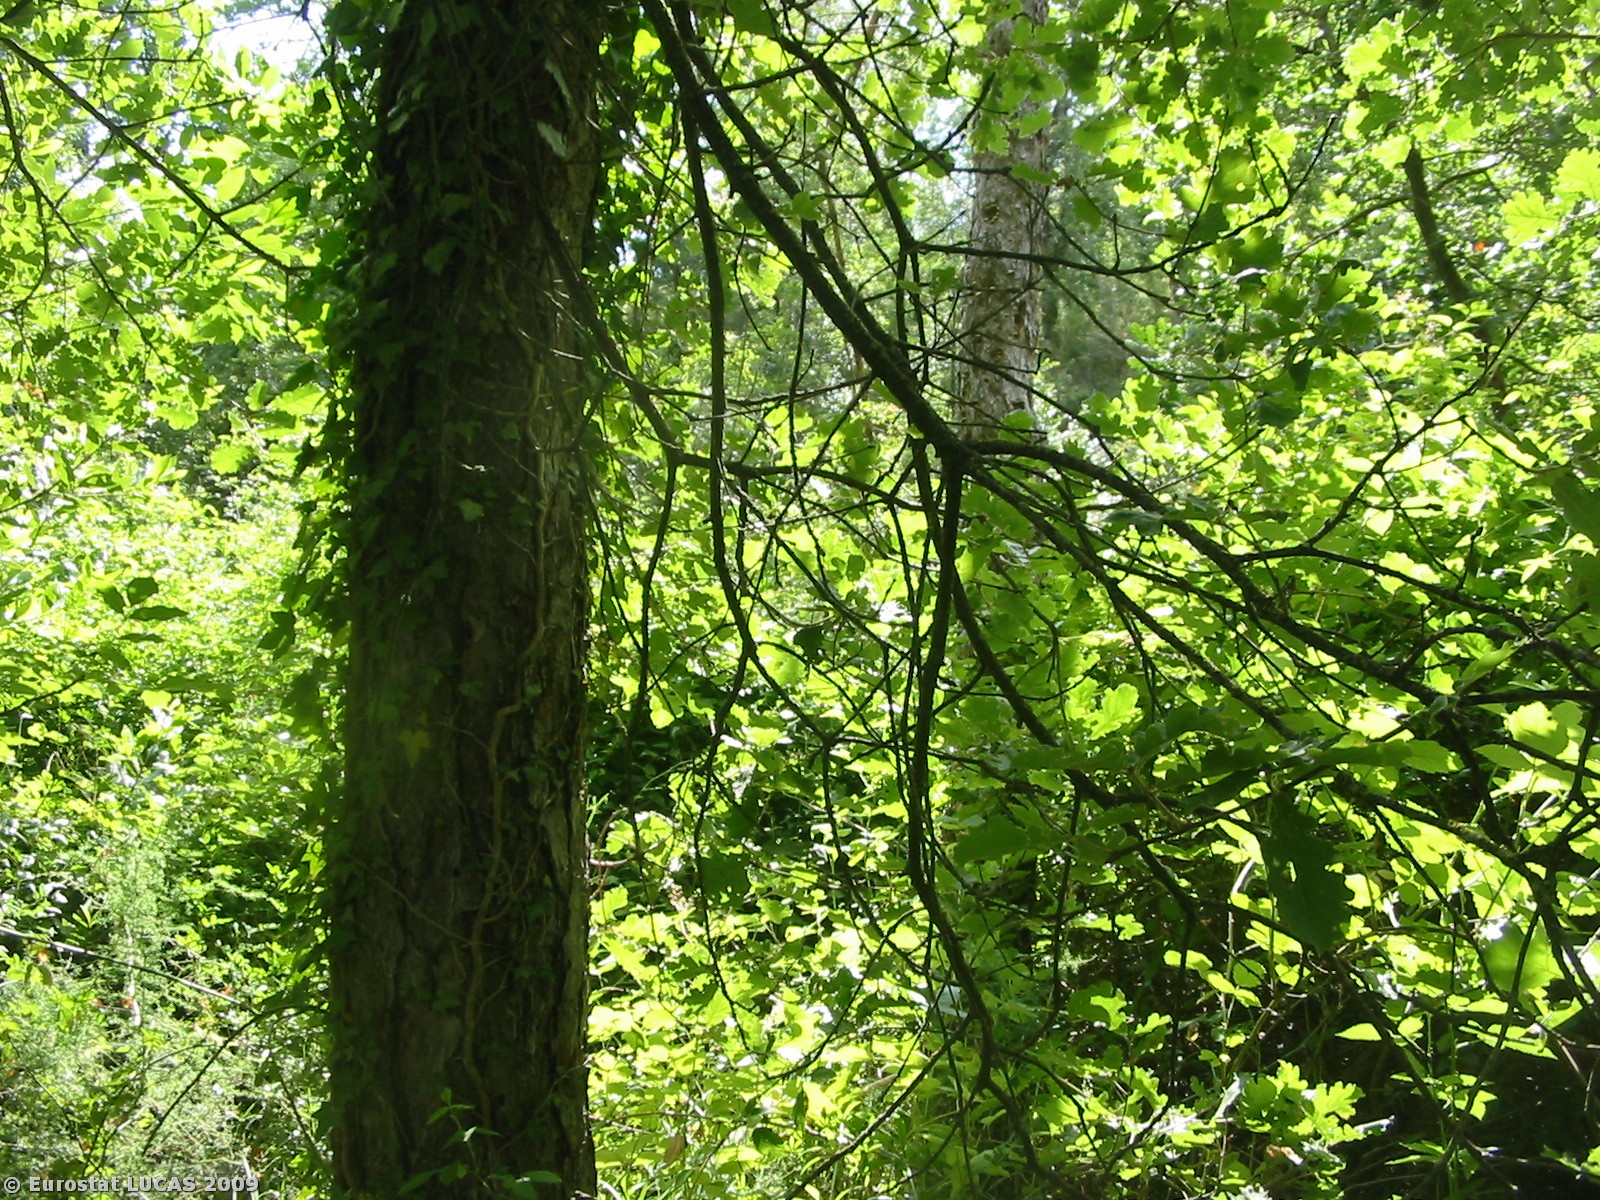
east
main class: Woodland
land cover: Mixed woodland
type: thermophilous deciduous forest
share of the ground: > 75 %
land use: Forestry
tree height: > 5 m
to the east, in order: Mixed woodland; Electric lines; Mixed woodland; Tracks; Fences; Mixed woodland; Fences; Tracks; Electric lines; Mixed woodland
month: June
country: IT
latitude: 43.4316
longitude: 11.8602
